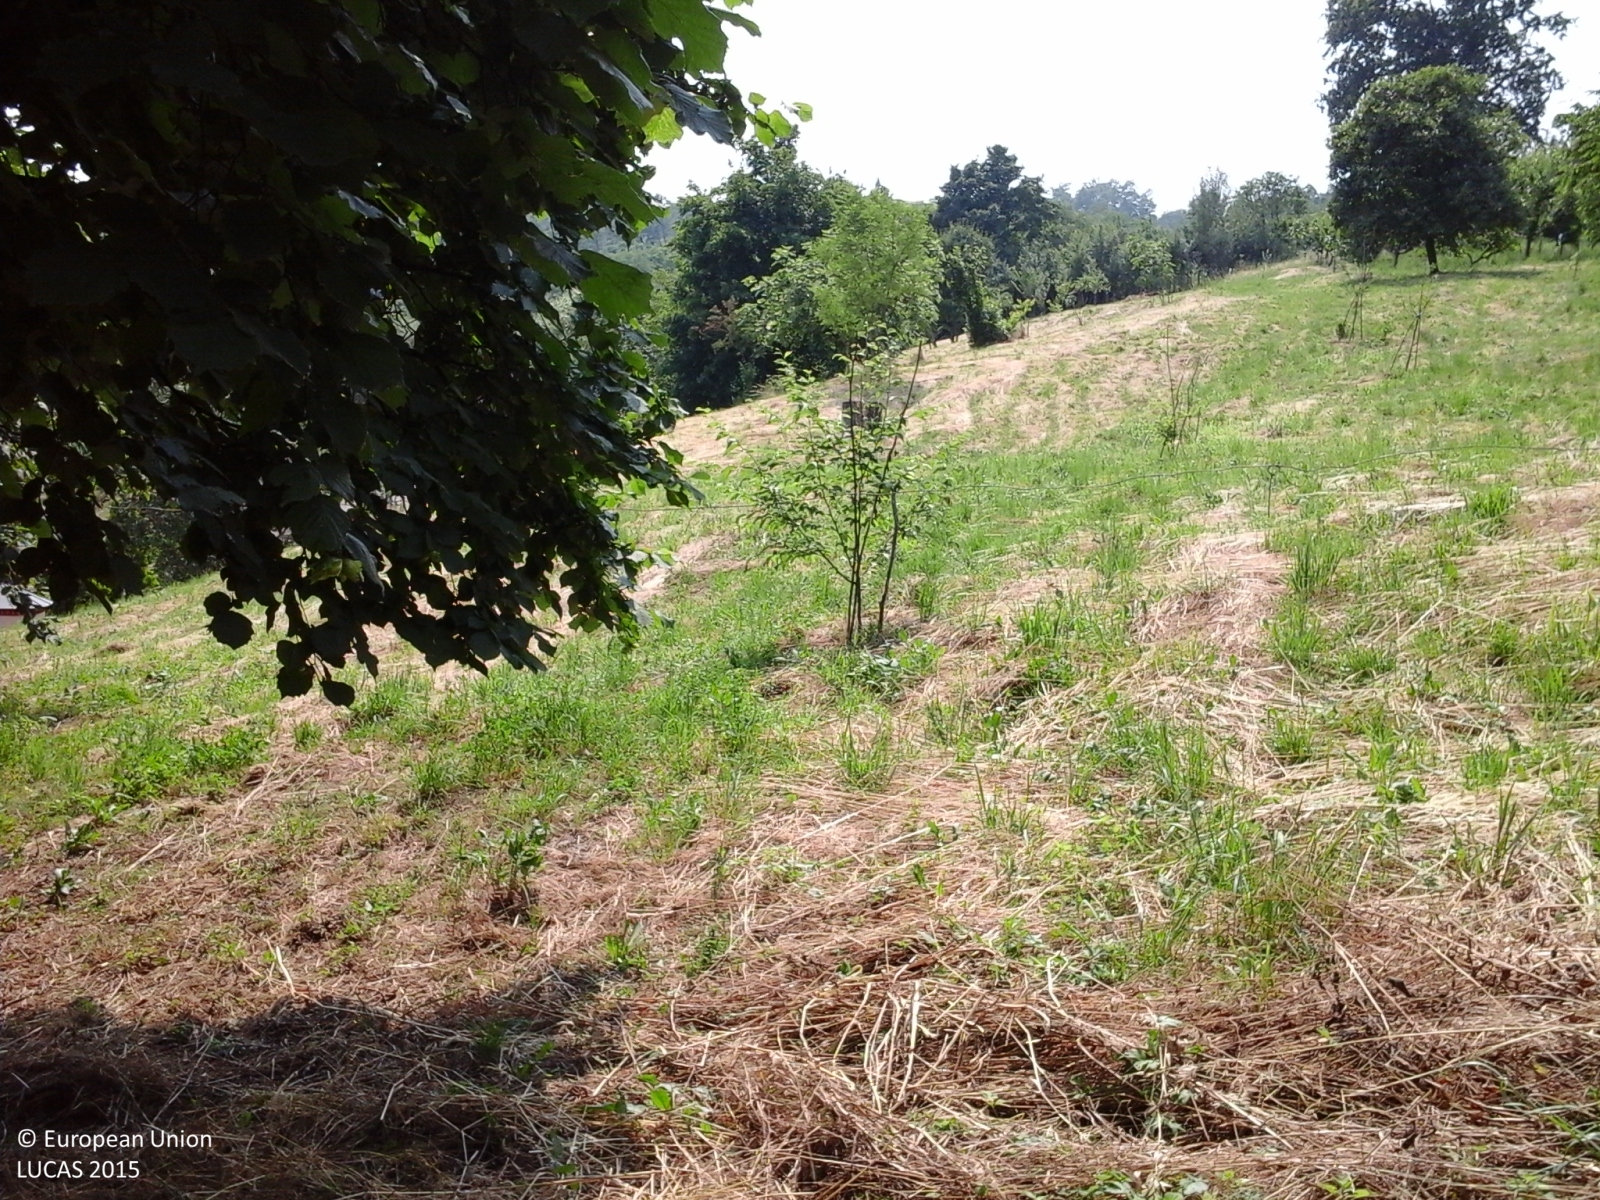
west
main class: Woodland
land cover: Broadleaved woodland
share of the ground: > 75 %
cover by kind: broadleaved forest trees 100 %
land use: Agriculture (excluding fallow land and kitchen gardens)
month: June
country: IT
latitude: 45.7445
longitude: 11.6042
